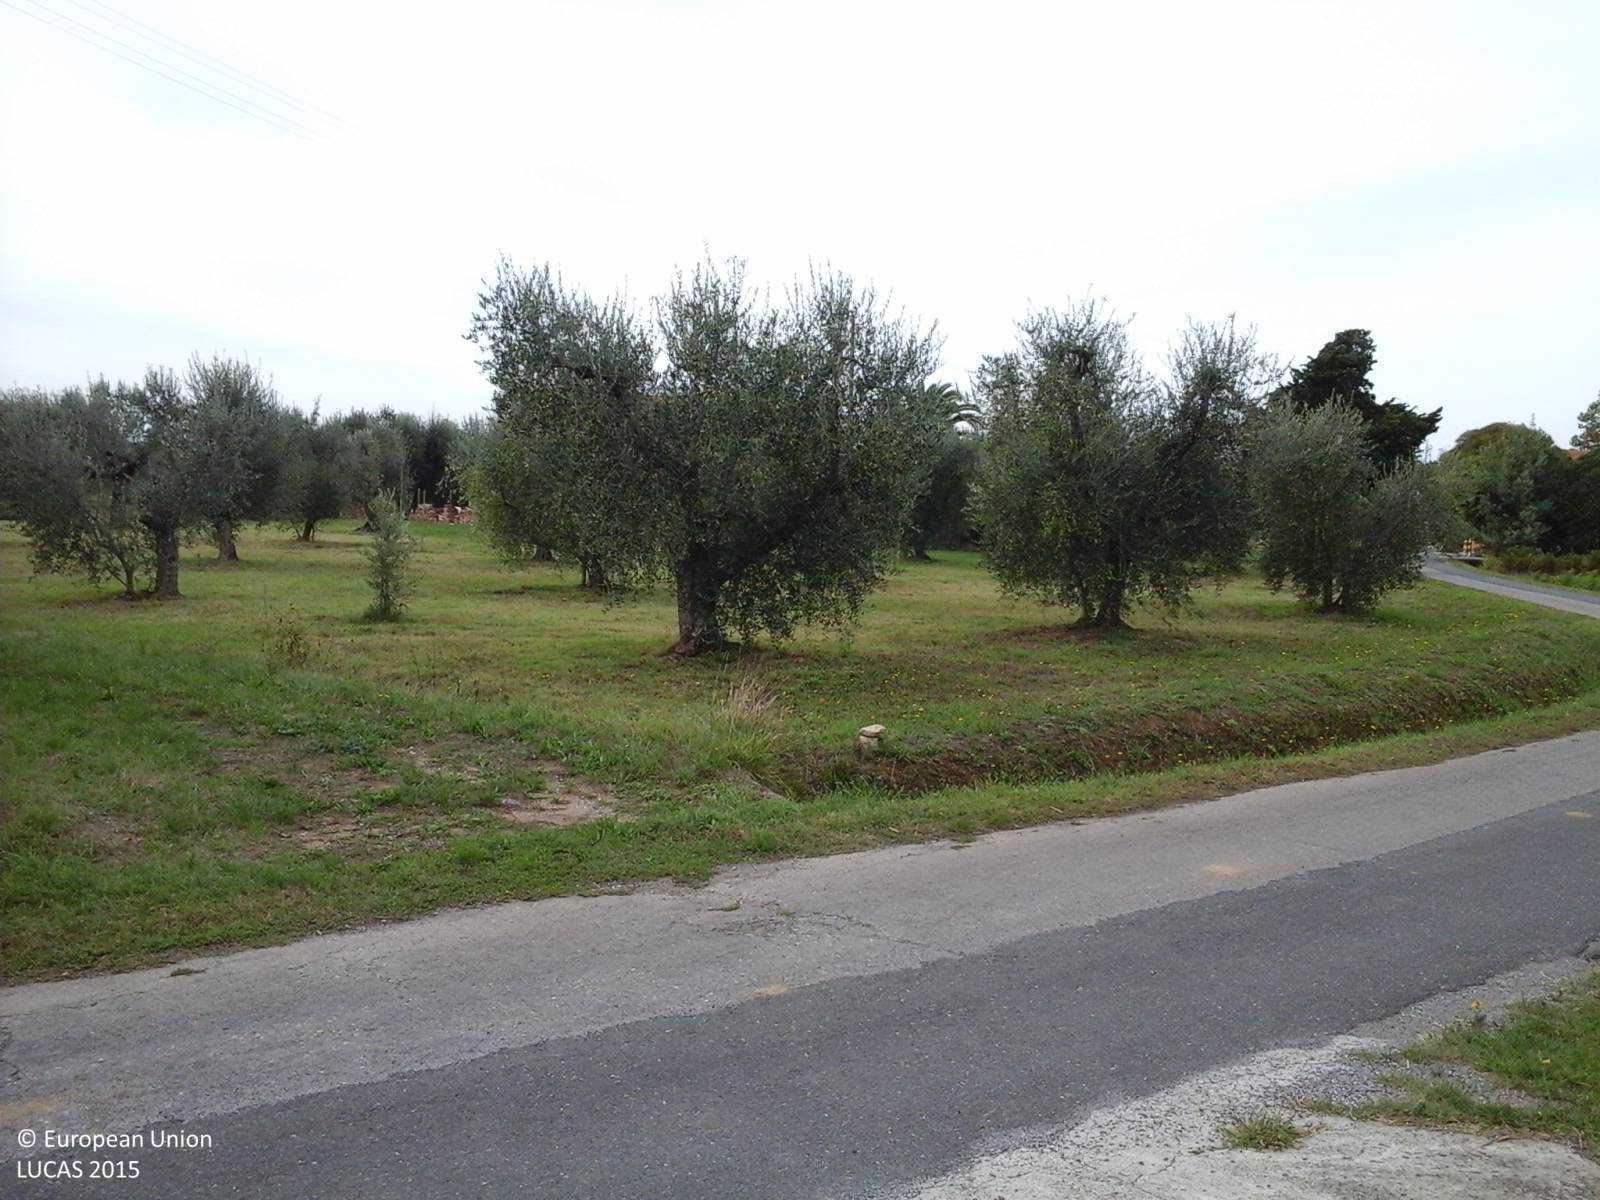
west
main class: Grassland
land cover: Grassland with sparse tree/shrub cover
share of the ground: 25 - 50 %
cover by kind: herbaceous plants 90 %, broadleaved forest trees 5 %, shrubs 5 %
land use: Residential
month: October
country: IT
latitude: 43.1759
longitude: 10.6010
